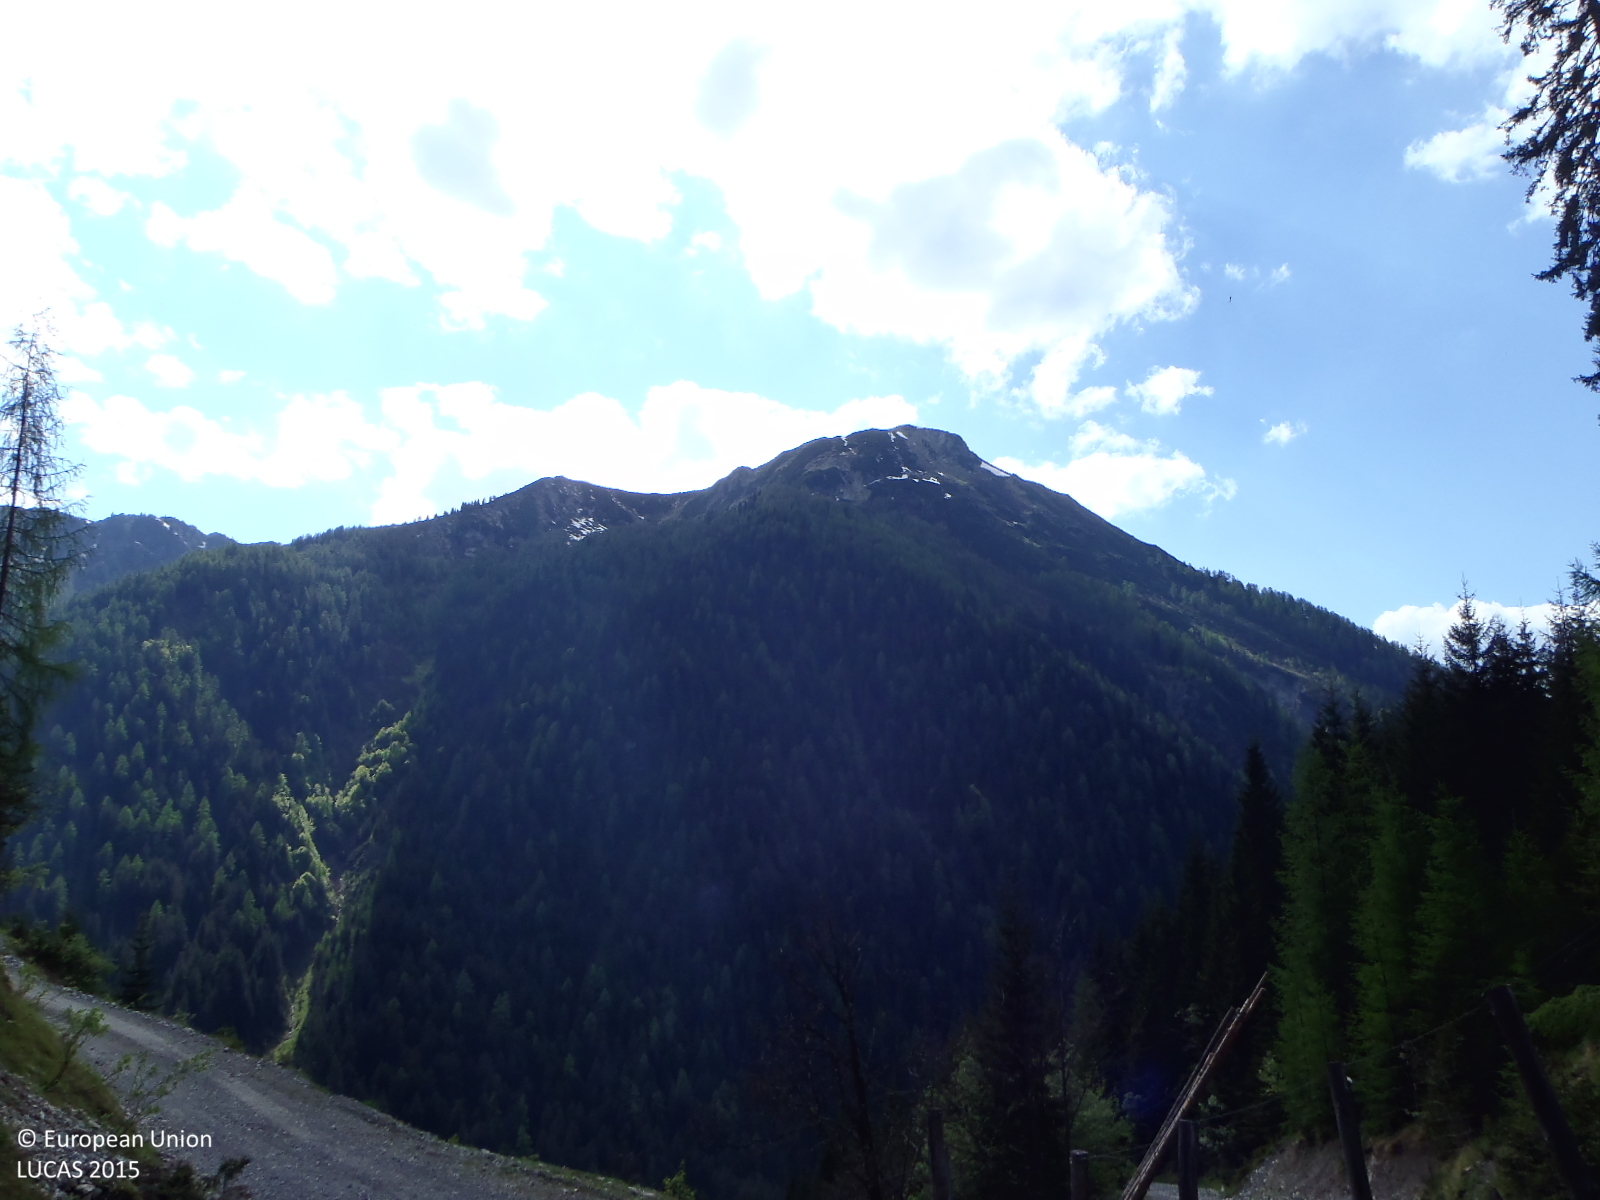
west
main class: Woodland
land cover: Spruce dominated coniferous woodland
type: alpine coniferous forest
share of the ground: 25 - 50 %
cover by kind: herbaceous plants 50 %, coniferous forest trees 40 %, shrubs 5 %, lichens and mosses 5 %
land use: Forestry
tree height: > 5 m
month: May
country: AT
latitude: 47.3229
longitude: 13.4514
